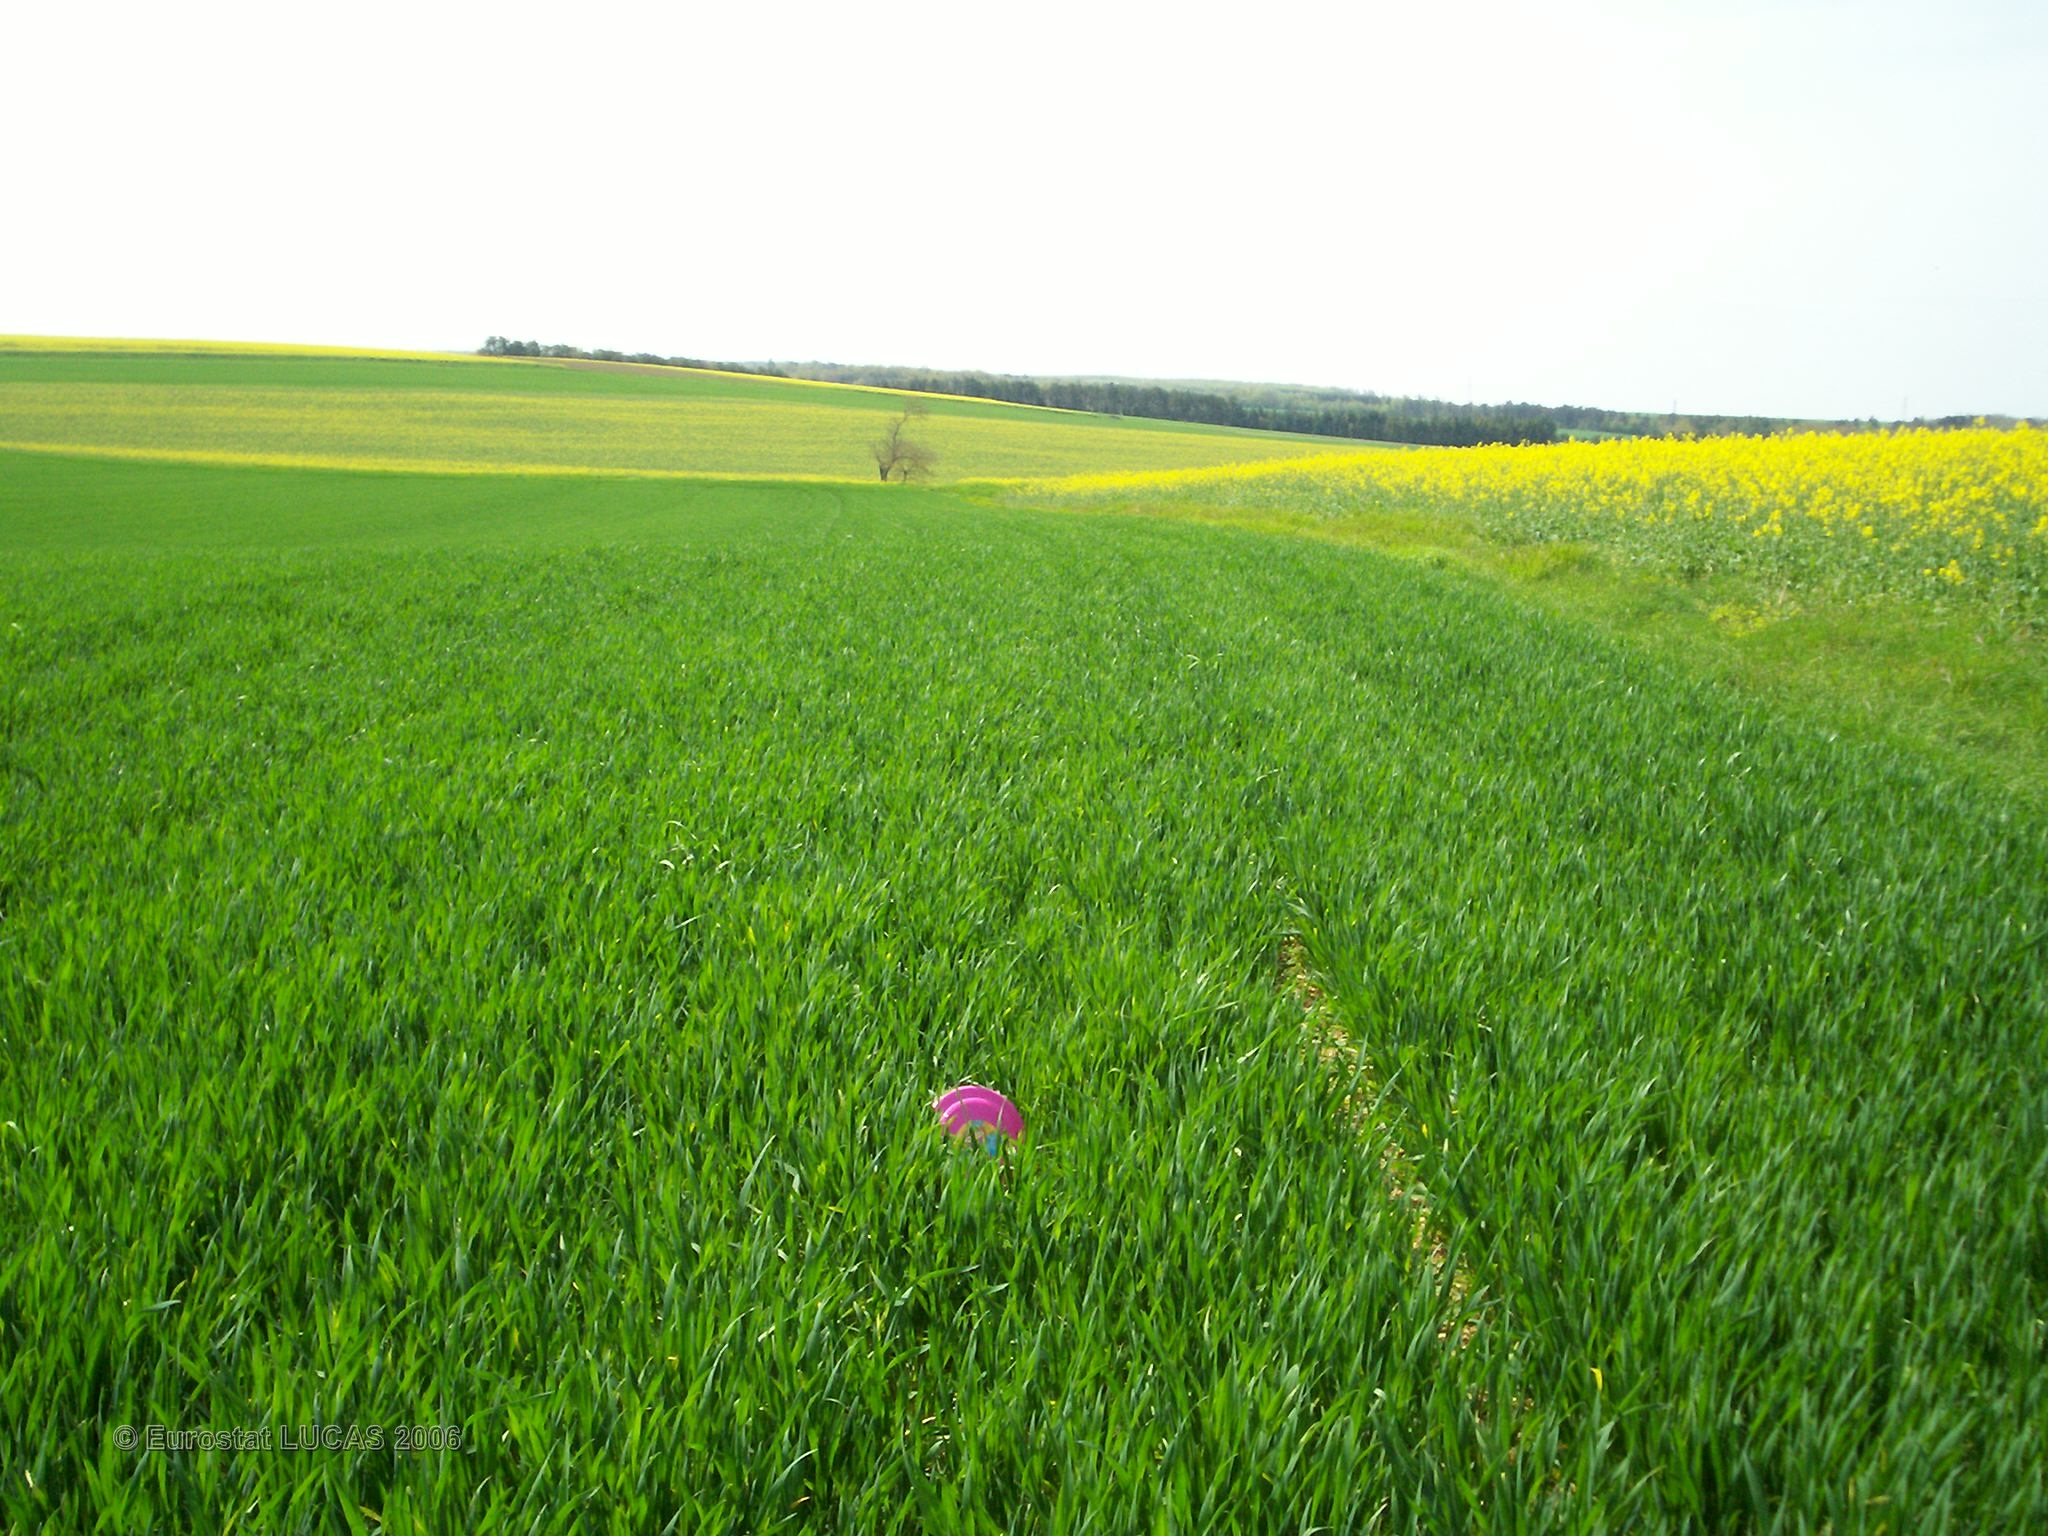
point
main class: Cropland
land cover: Common wheat
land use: Agriculture (excluding fallow land and kitchen gardens)
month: May
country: FR
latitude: 47.8884
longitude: 3.8310
